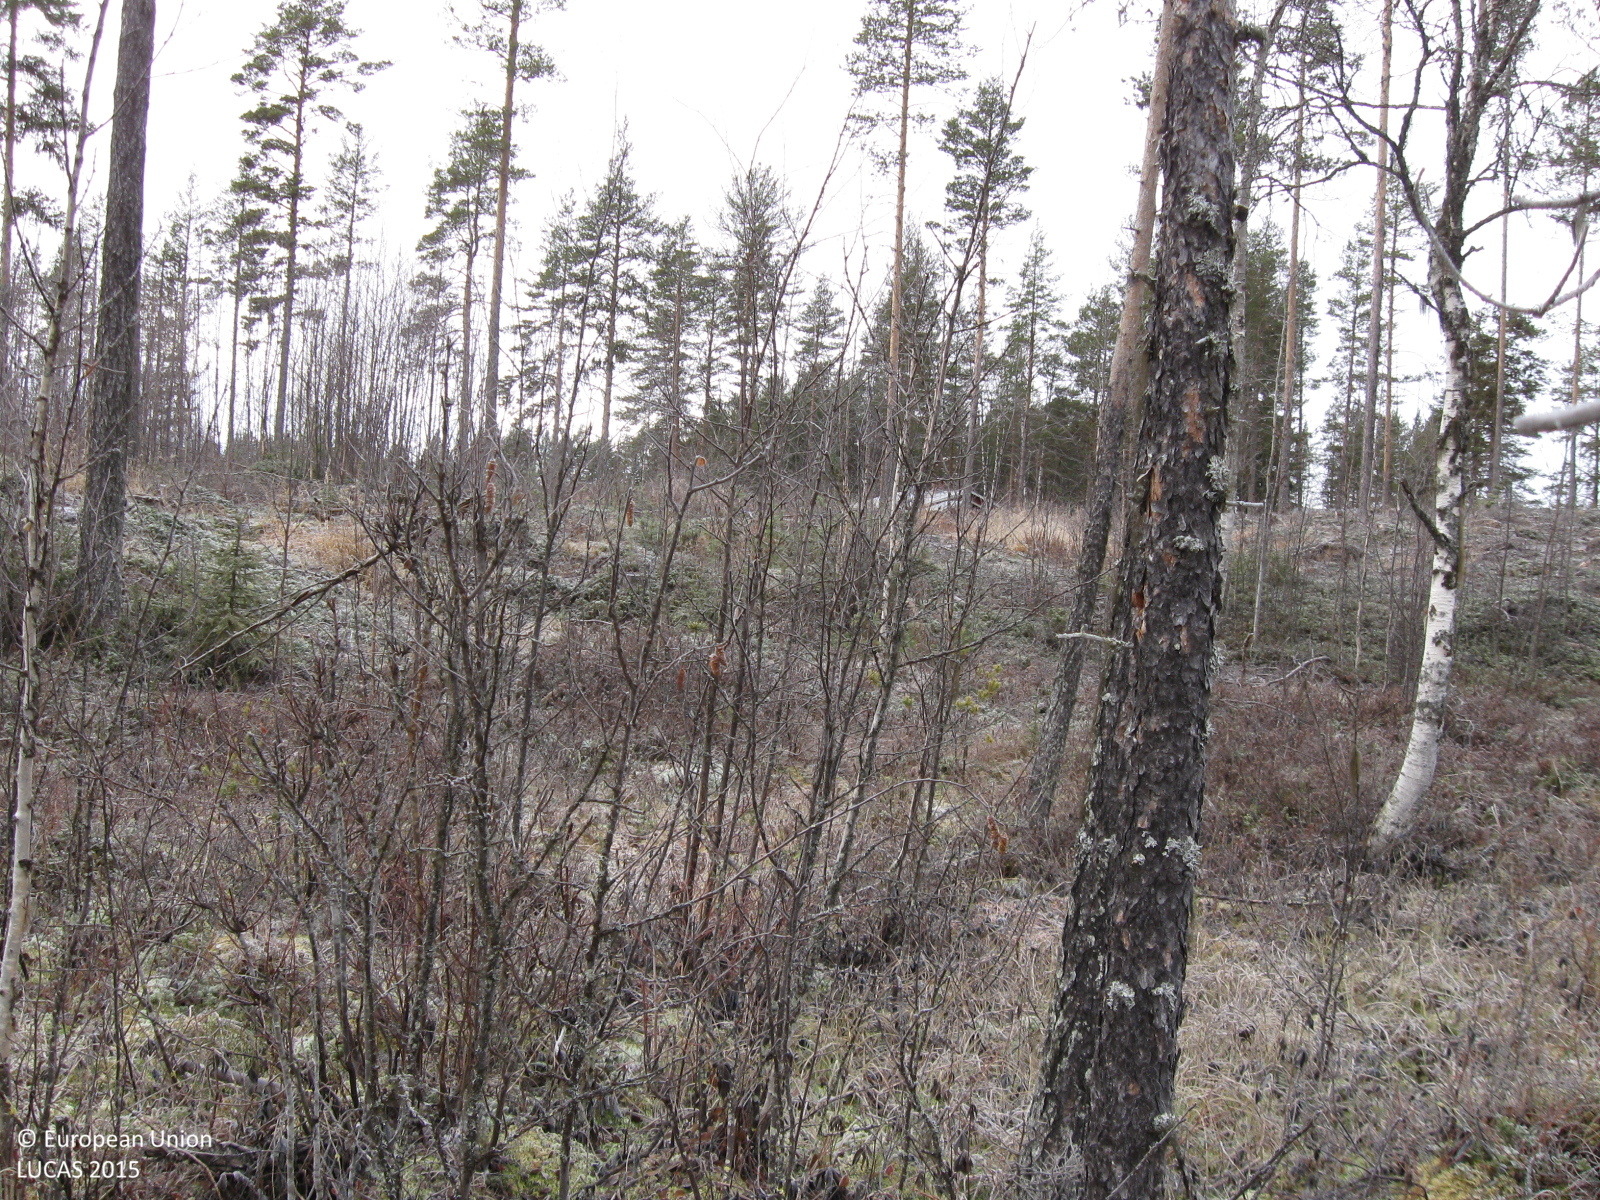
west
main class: Woodland
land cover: Pine dominated mixed woodland
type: mire and swamp forests
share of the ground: 25 - 50 %
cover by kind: lichens and mosses 30 %, shrubs 25 %, herbaceous plants 20 %, broadleaved forest trees 15 %, coniferous forest trees 10 %
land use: Semi-natural and natural areas not in use
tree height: > 5 m
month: October
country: SE
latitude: 66.2273
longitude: 21.5487
